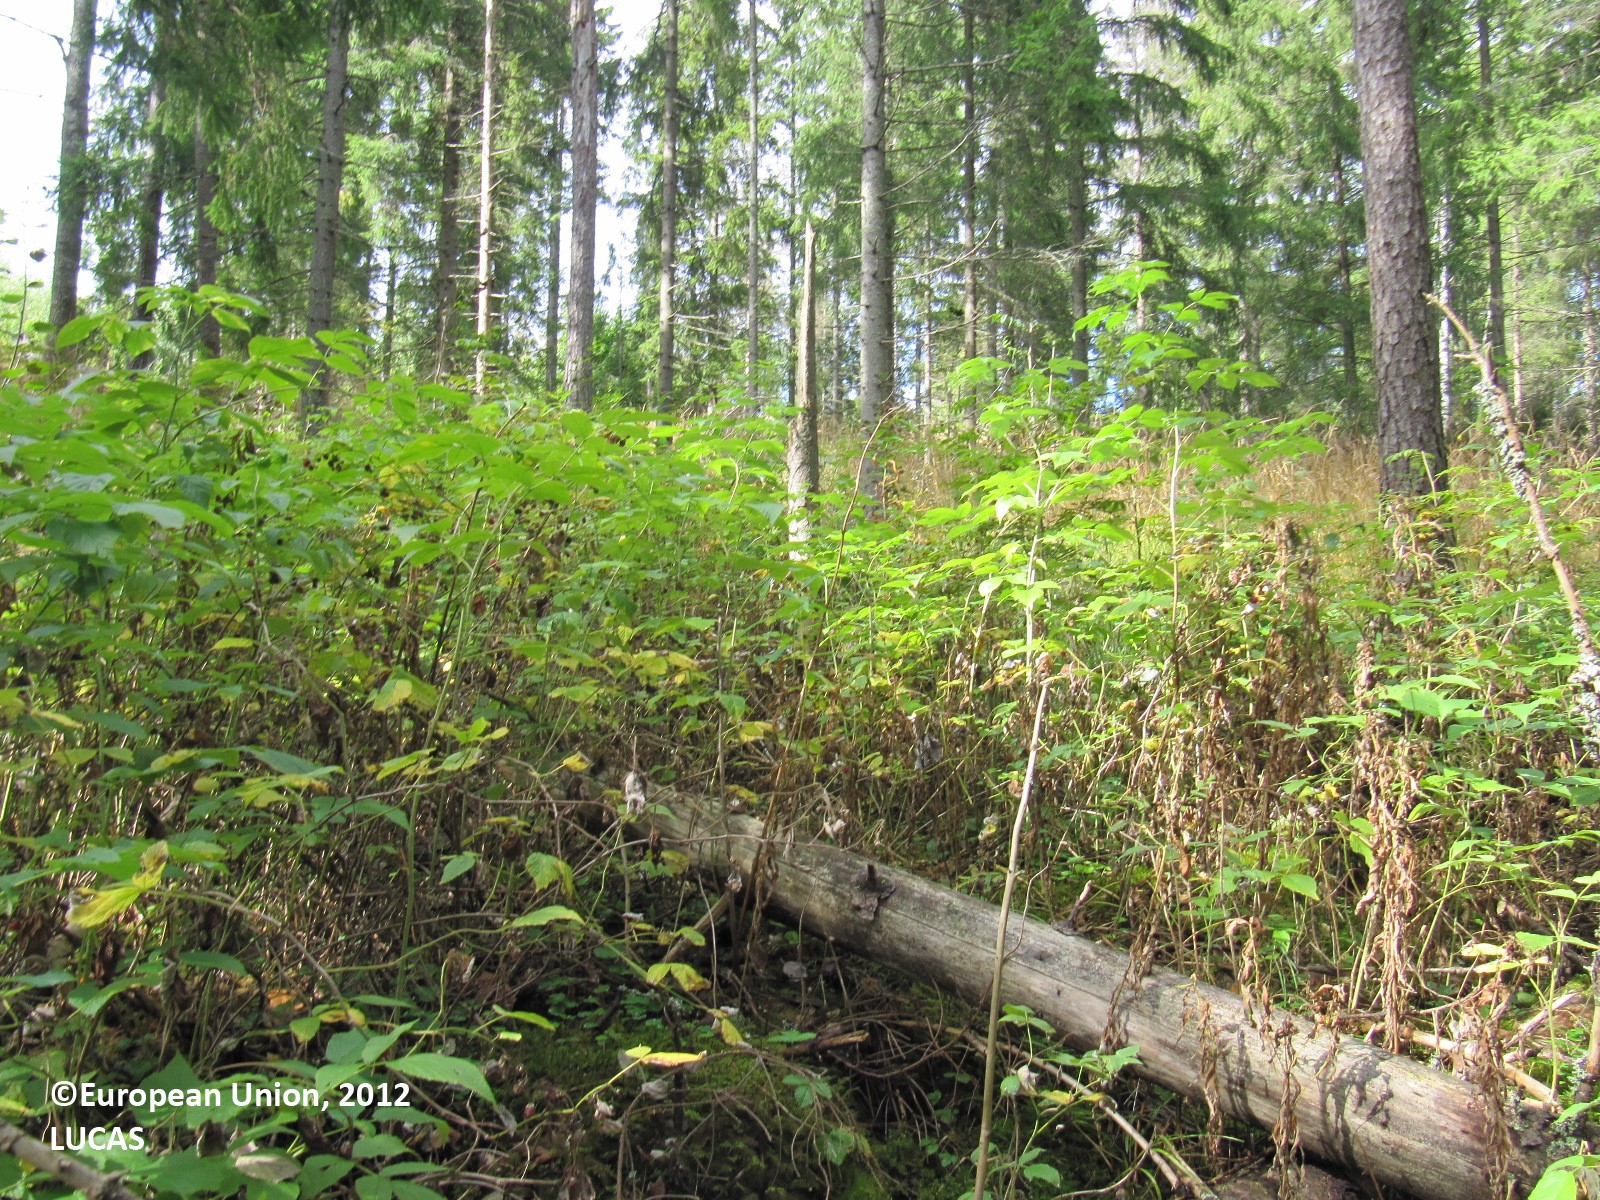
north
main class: Woodland
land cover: Spruce dominated mixed woodland
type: boreal forest
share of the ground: 50 - 75 %
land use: Forestry
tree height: > 5 m
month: August
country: FI
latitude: 60.2166
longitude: 24.1240
